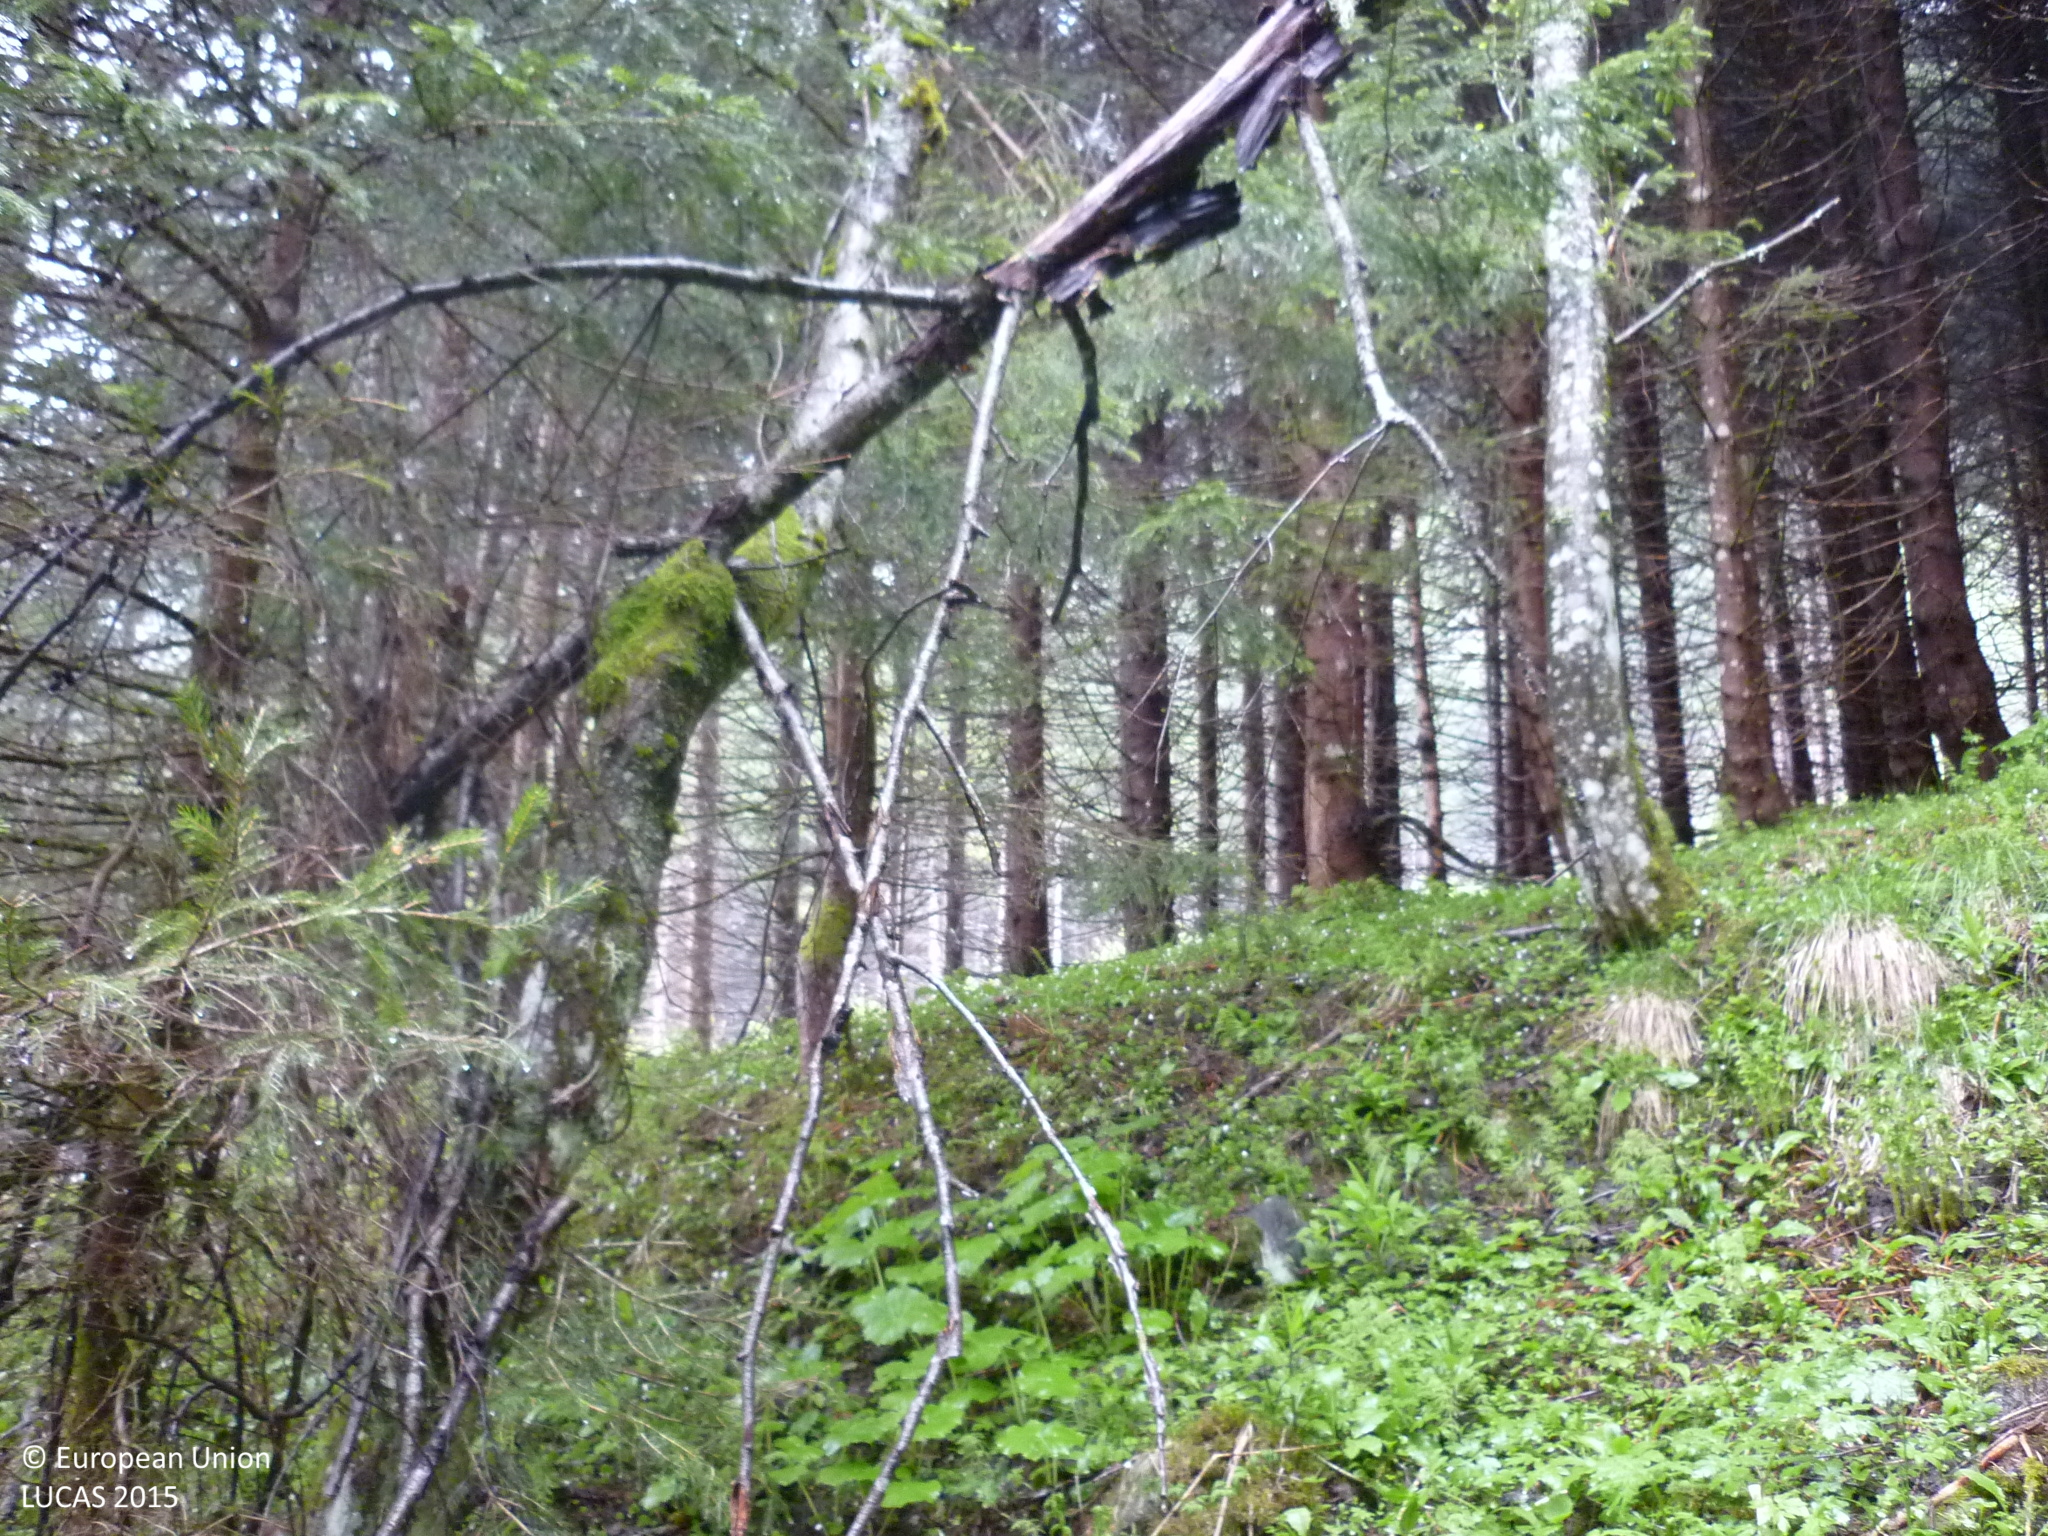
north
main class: Woodland
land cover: Spruce dominated coniferous woodland
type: alpine coniferous forest
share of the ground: > 75 %
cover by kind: coniferous forest trees 70 %, broadleaved forest trees 15 %, herbaceous plants 15 %
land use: Forestry
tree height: > 5 m
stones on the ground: < 10 %
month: May
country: AT
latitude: 47.3518
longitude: 14.1686
